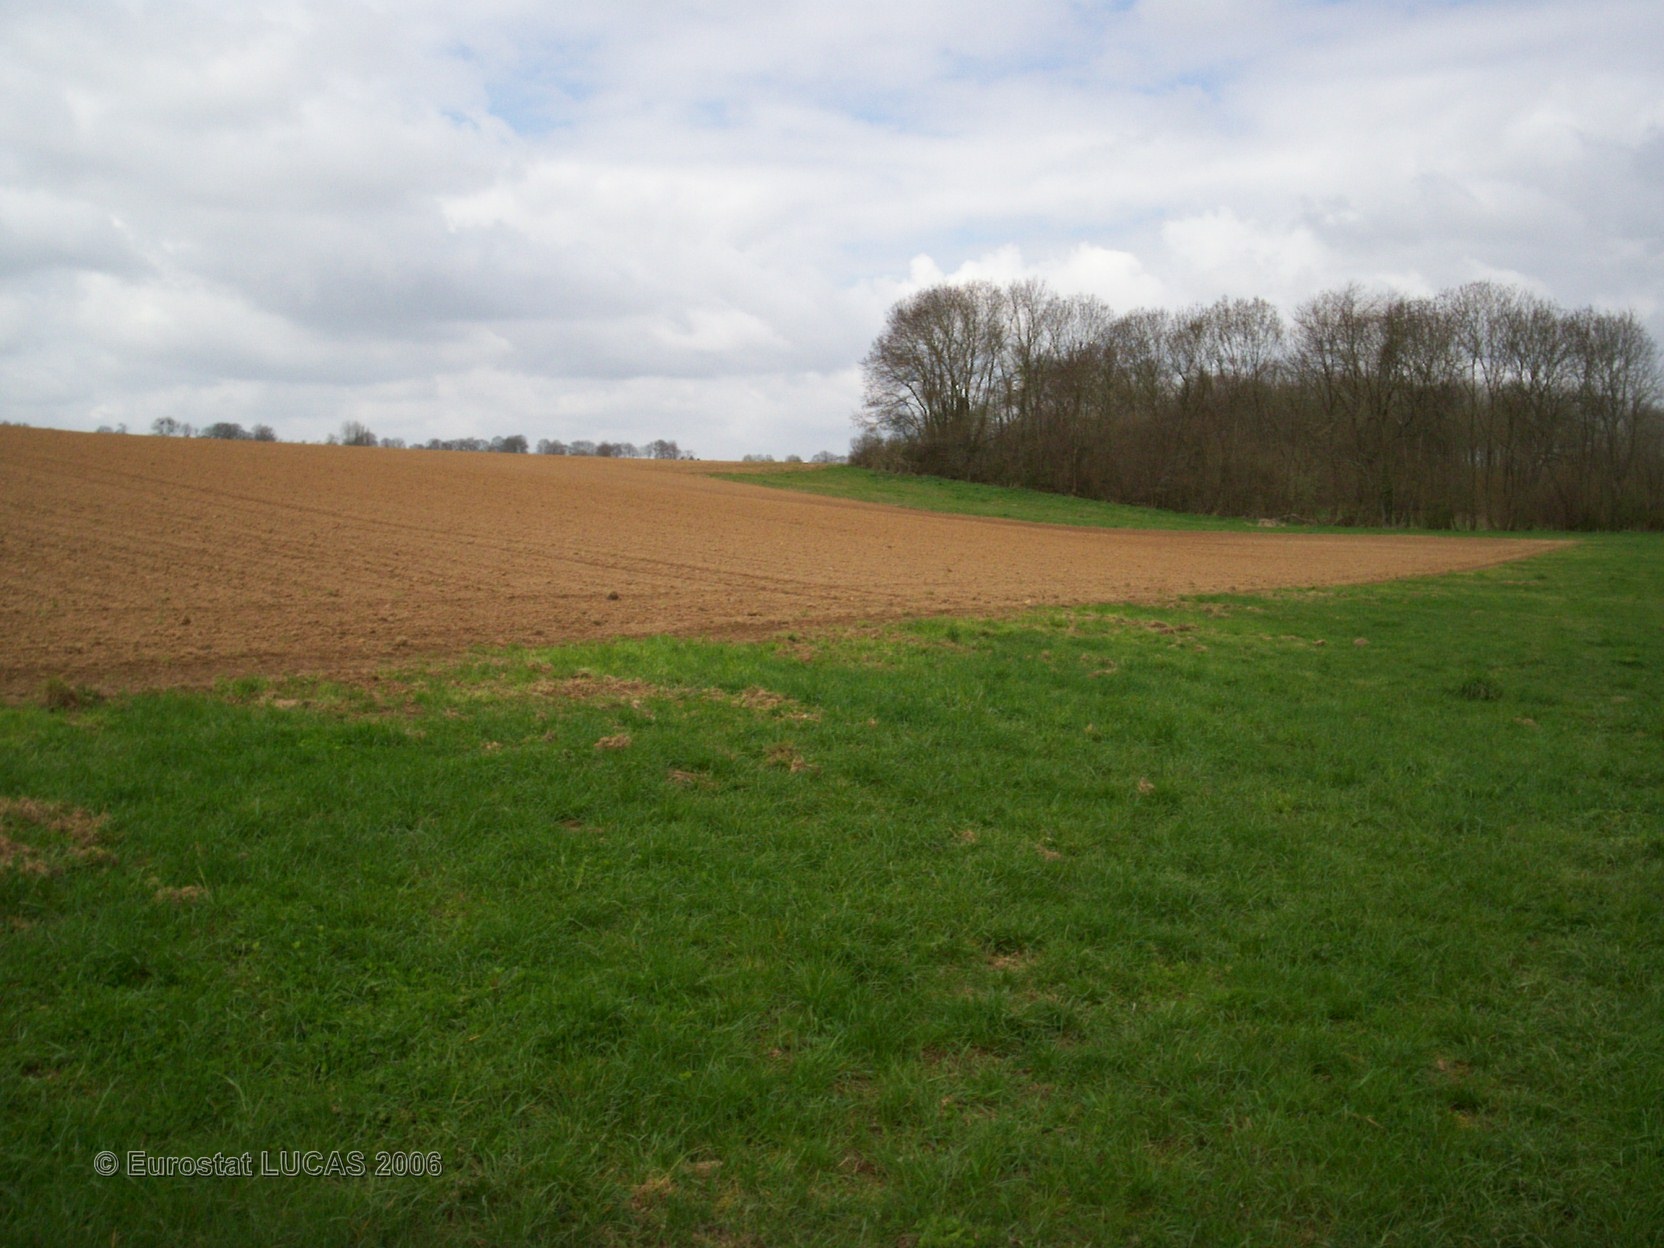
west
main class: Grassland
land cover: Grassland without tree/shrub cover
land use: Agriculture (excluding fallow land and kitchen gardens)
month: April
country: FR
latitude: 49.7306
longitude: 0.9173
